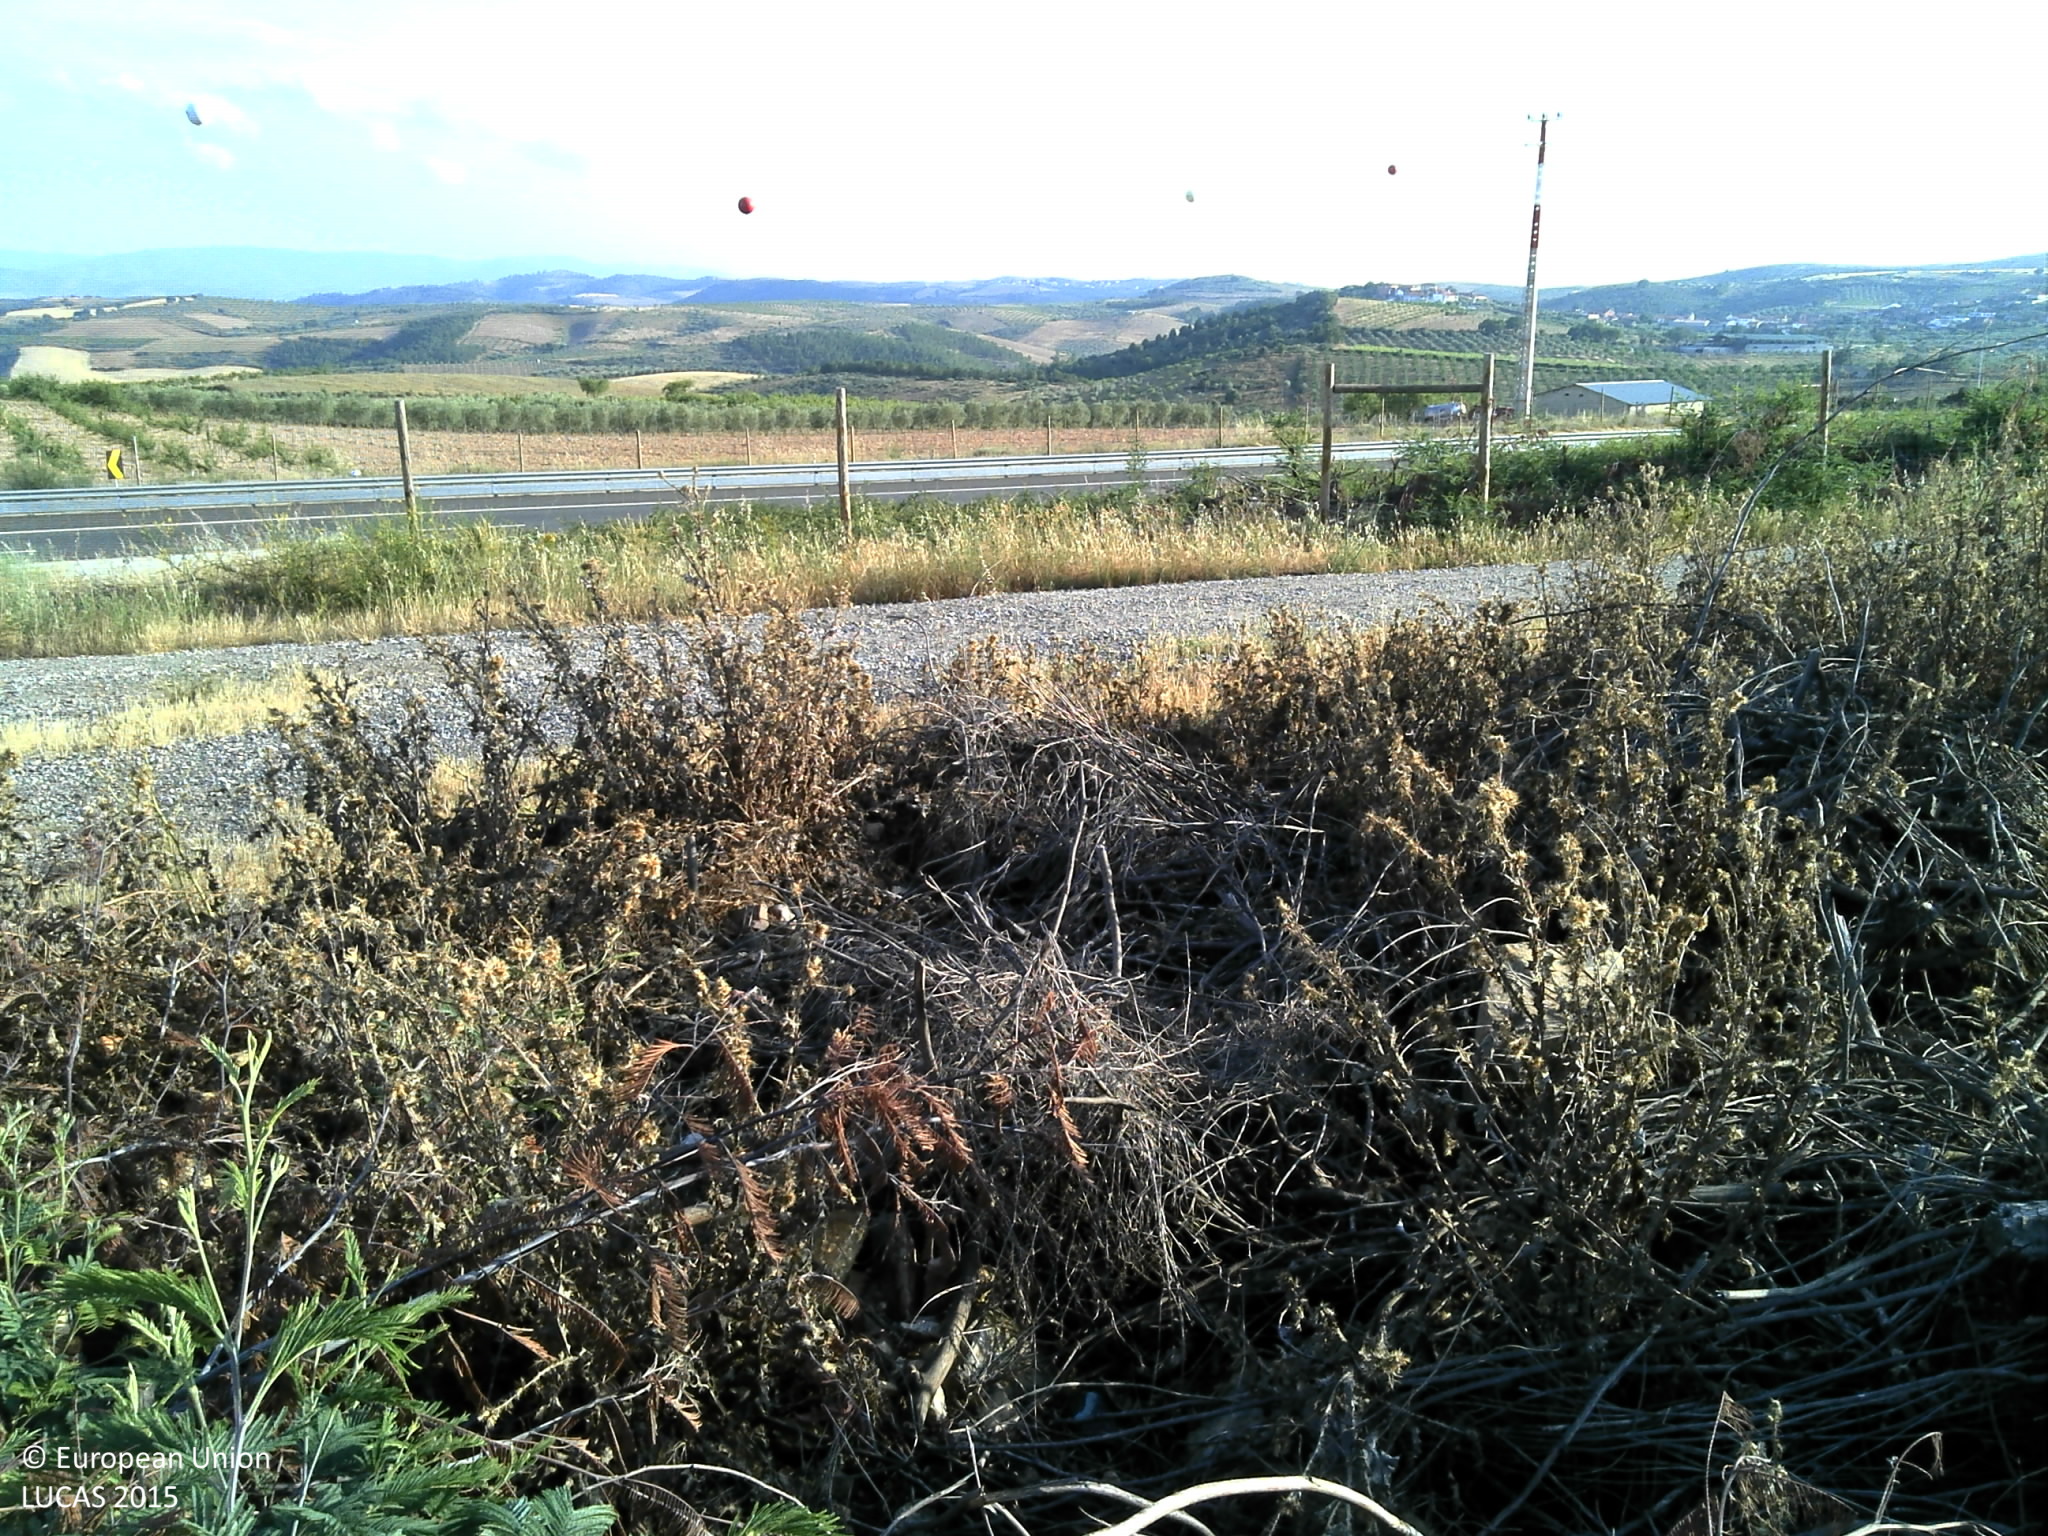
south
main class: Woodland
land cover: Broadleaved woodland
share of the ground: 10 - 25 %
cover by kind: unconsolidated bare surface 65 %, broadleaved forest trees 15 %, herbaceous plants 10 %, consolidated bare surface 10 %
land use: Semi-natural and natural areas not in use
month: June
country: PT
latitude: 41.4514
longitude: -7.2744
